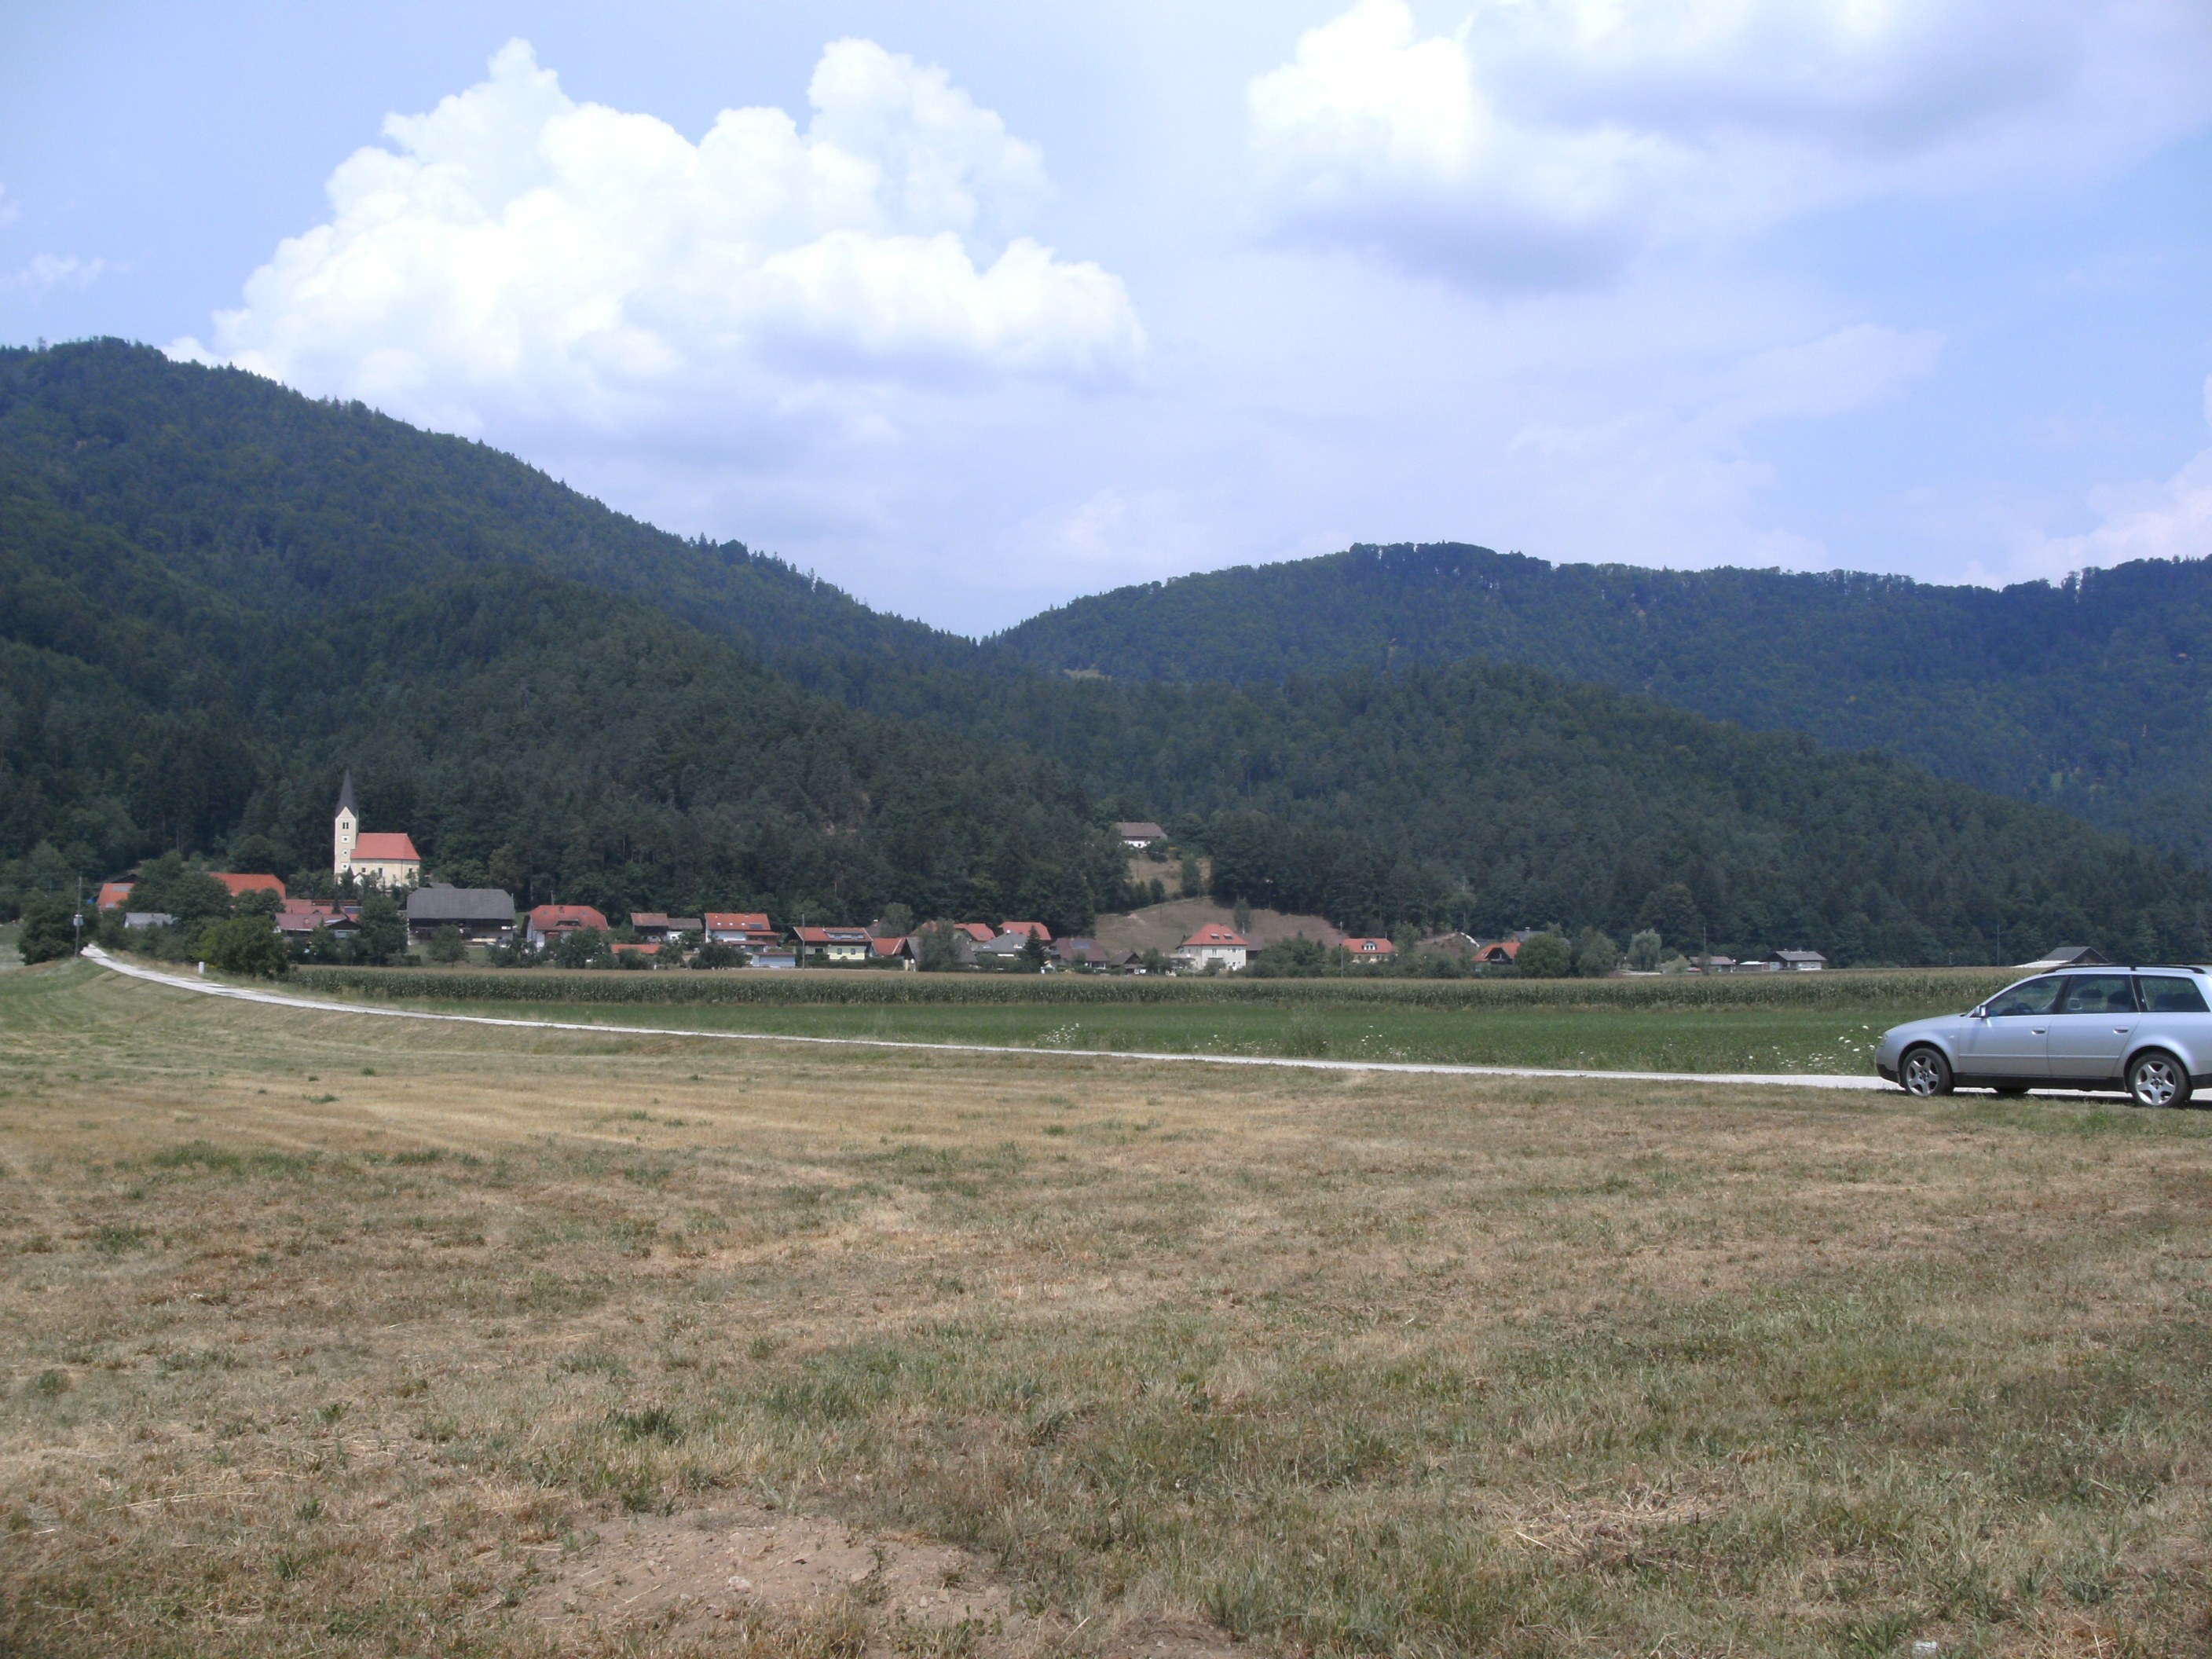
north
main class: Grassland
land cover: Grassland without tree/shrub cover
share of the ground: > 75 %
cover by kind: herbaceous plants 80 %, unconsolidated bare surface 20 %
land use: Agriculture (excluding fallow land and kitchen gardens)
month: July
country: AT
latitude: 46.6575
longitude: 14.8201
